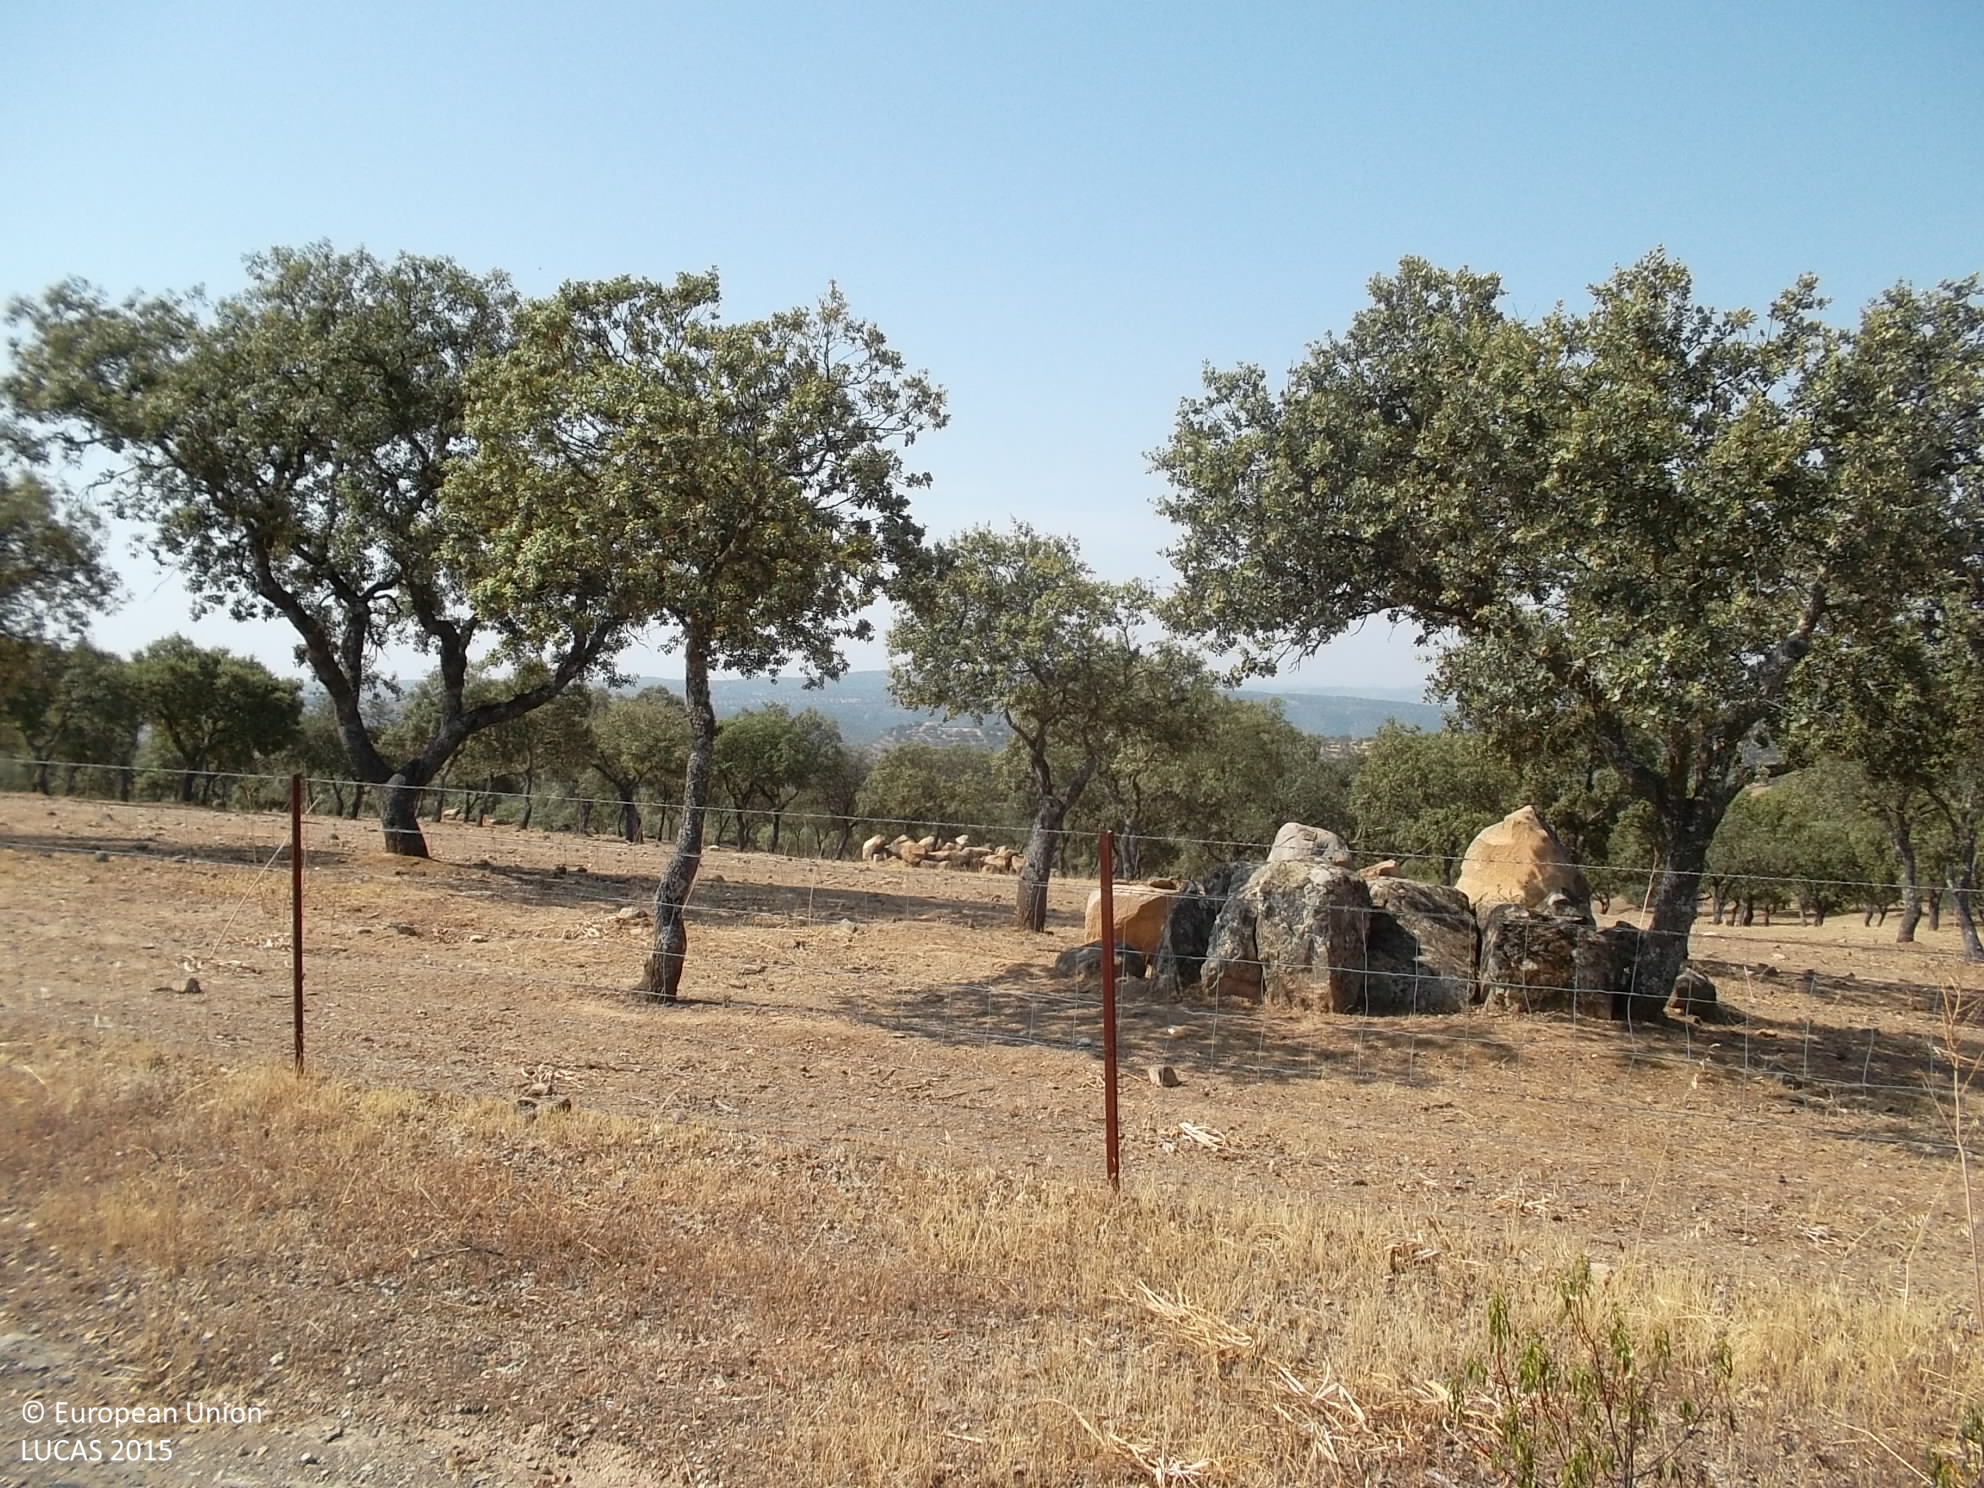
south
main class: Shrubland
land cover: Shrubland with sparse tree cover
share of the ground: 25 - 50 %
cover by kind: herbaceous plants 55 %, shrubs 40 %, broadleaved forest trees 5 %
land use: Semi-natural and natural areas not in use
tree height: < 5 m
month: July
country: ES
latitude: 38.2172
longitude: -4.6957
